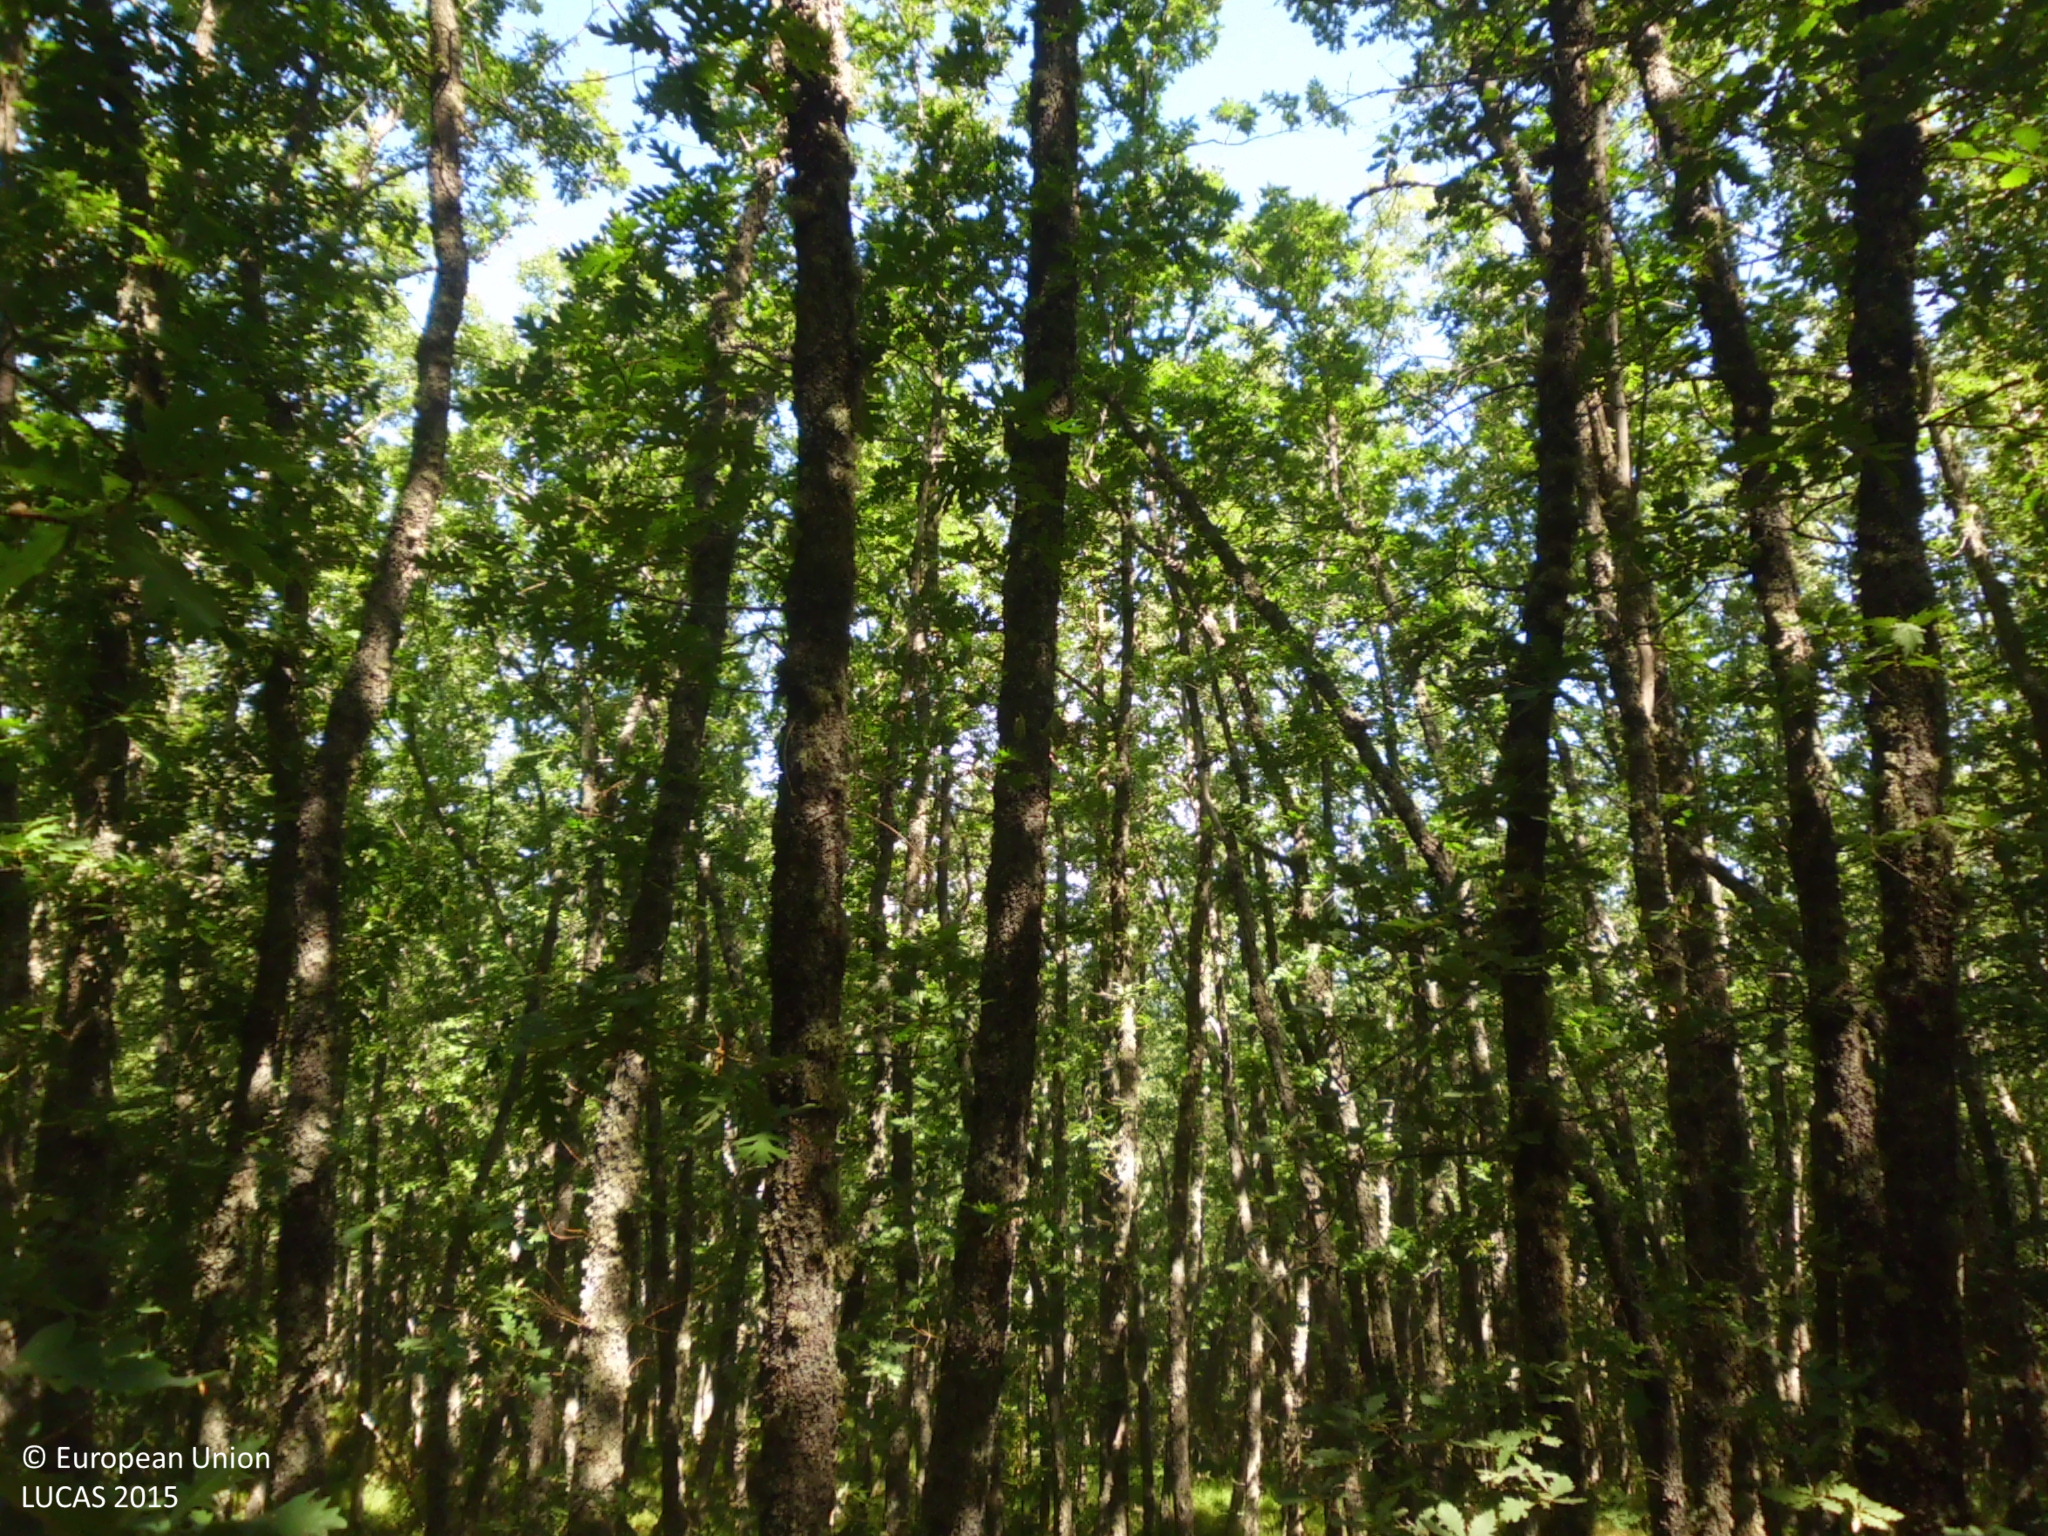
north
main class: Woodland
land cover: Broadleaved woodland
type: acidophilous oak and oak-birch forest
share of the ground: > 75 %
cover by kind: broadleaved forest trees 100 %
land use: Semi-natural and natural areas not in use
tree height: > 5 m
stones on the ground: 10 - 25 %
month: July
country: ES
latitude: 42.2268
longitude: -3.3207
